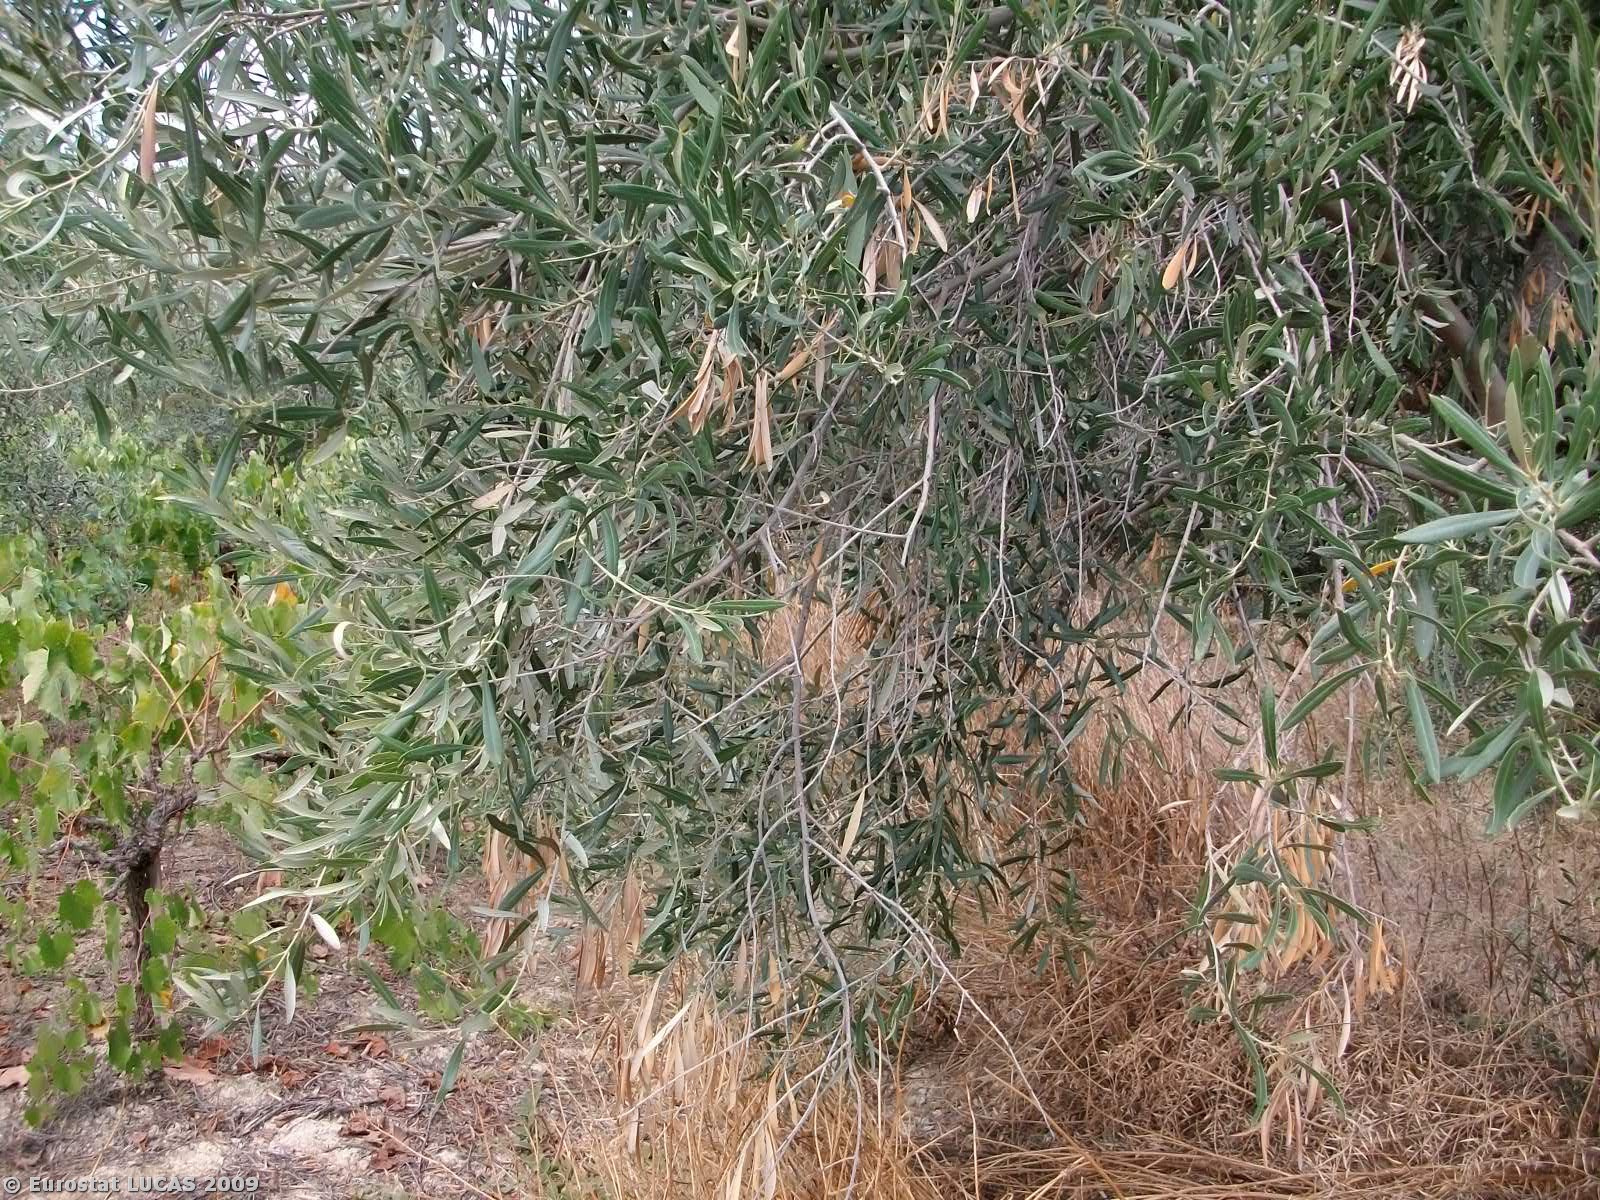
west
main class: Cropland
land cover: Olive groves
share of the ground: 50 - 75 %
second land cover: Vineyards
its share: < 10 %
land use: Agriculture (excluding fallow land and kitchen gardens)
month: September
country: GR
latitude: 38.0172
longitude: 22.5109
